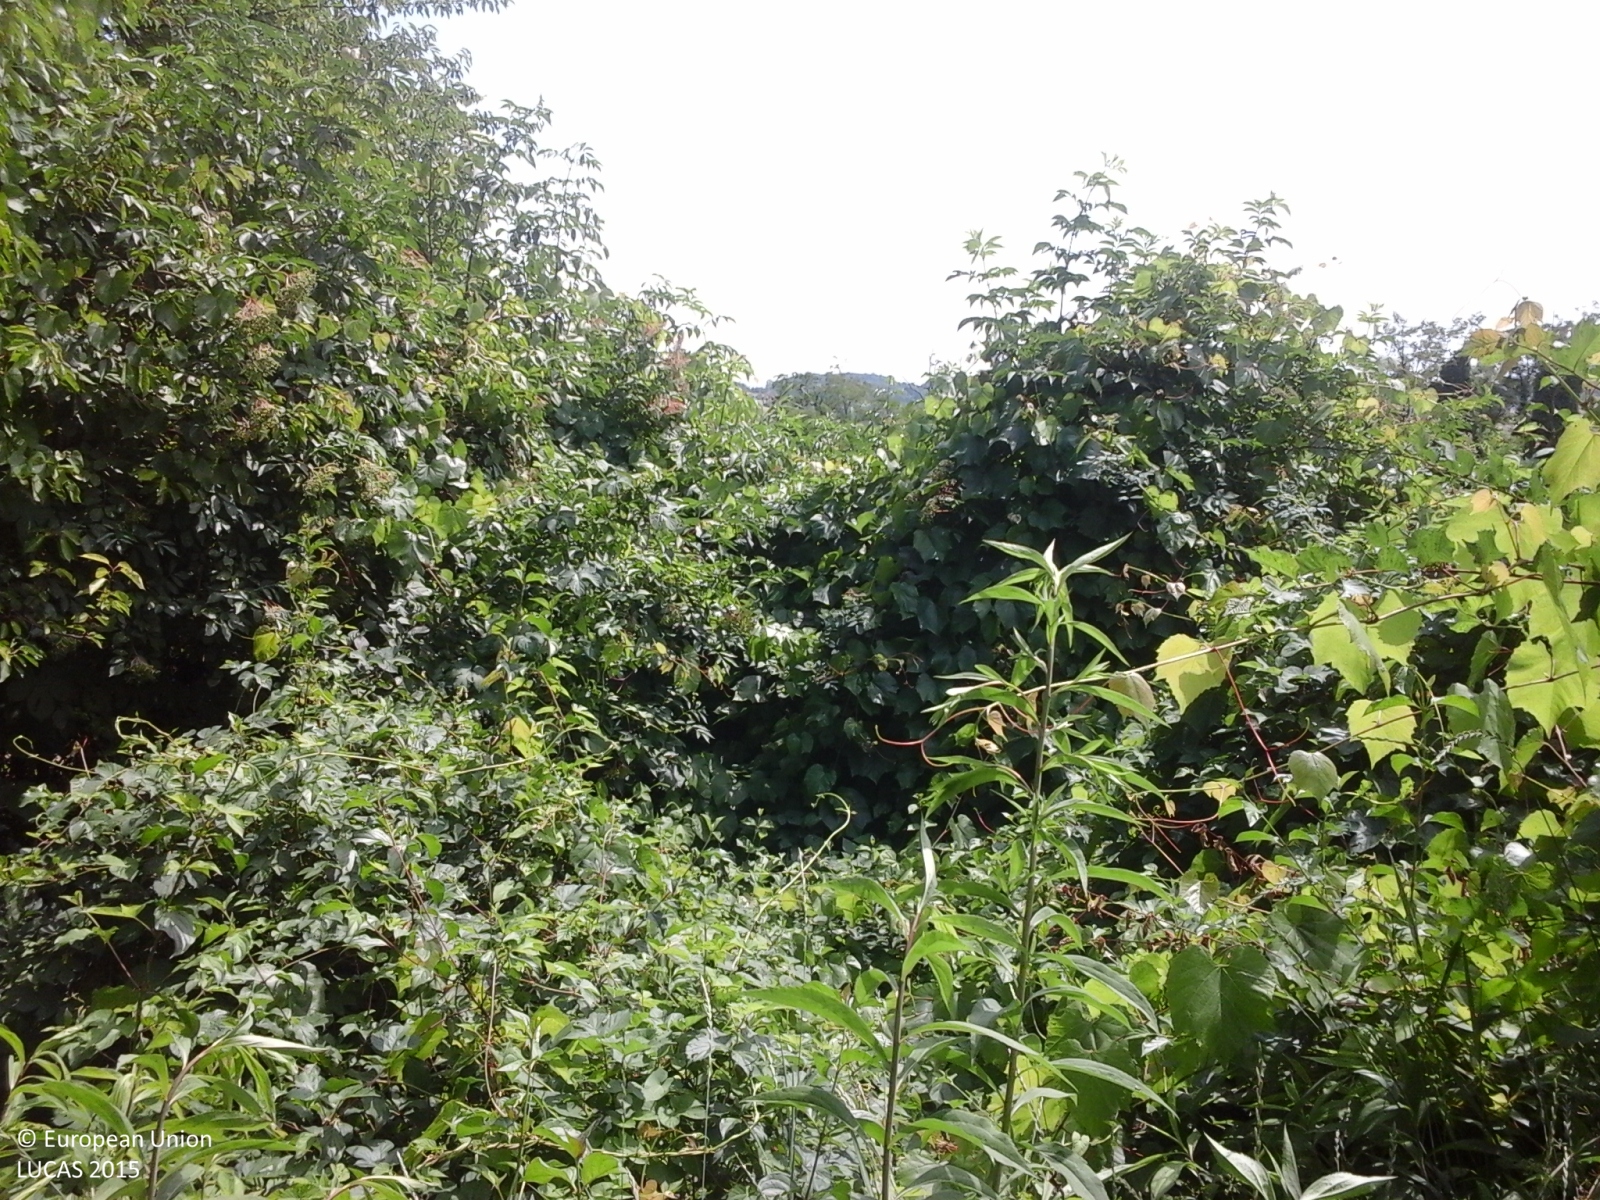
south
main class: Woodland
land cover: Broadleaved woodland
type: thermophilous deciduous forest
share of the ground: > 75 %
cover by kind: broadleaved forest trees 80 %, shrubs 10 %, herbaceous plants 10 %
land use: Semi-natural and natural areas not in use
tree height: > 5 m
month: June
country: IT
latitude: 45.0054
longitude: 8.3918
